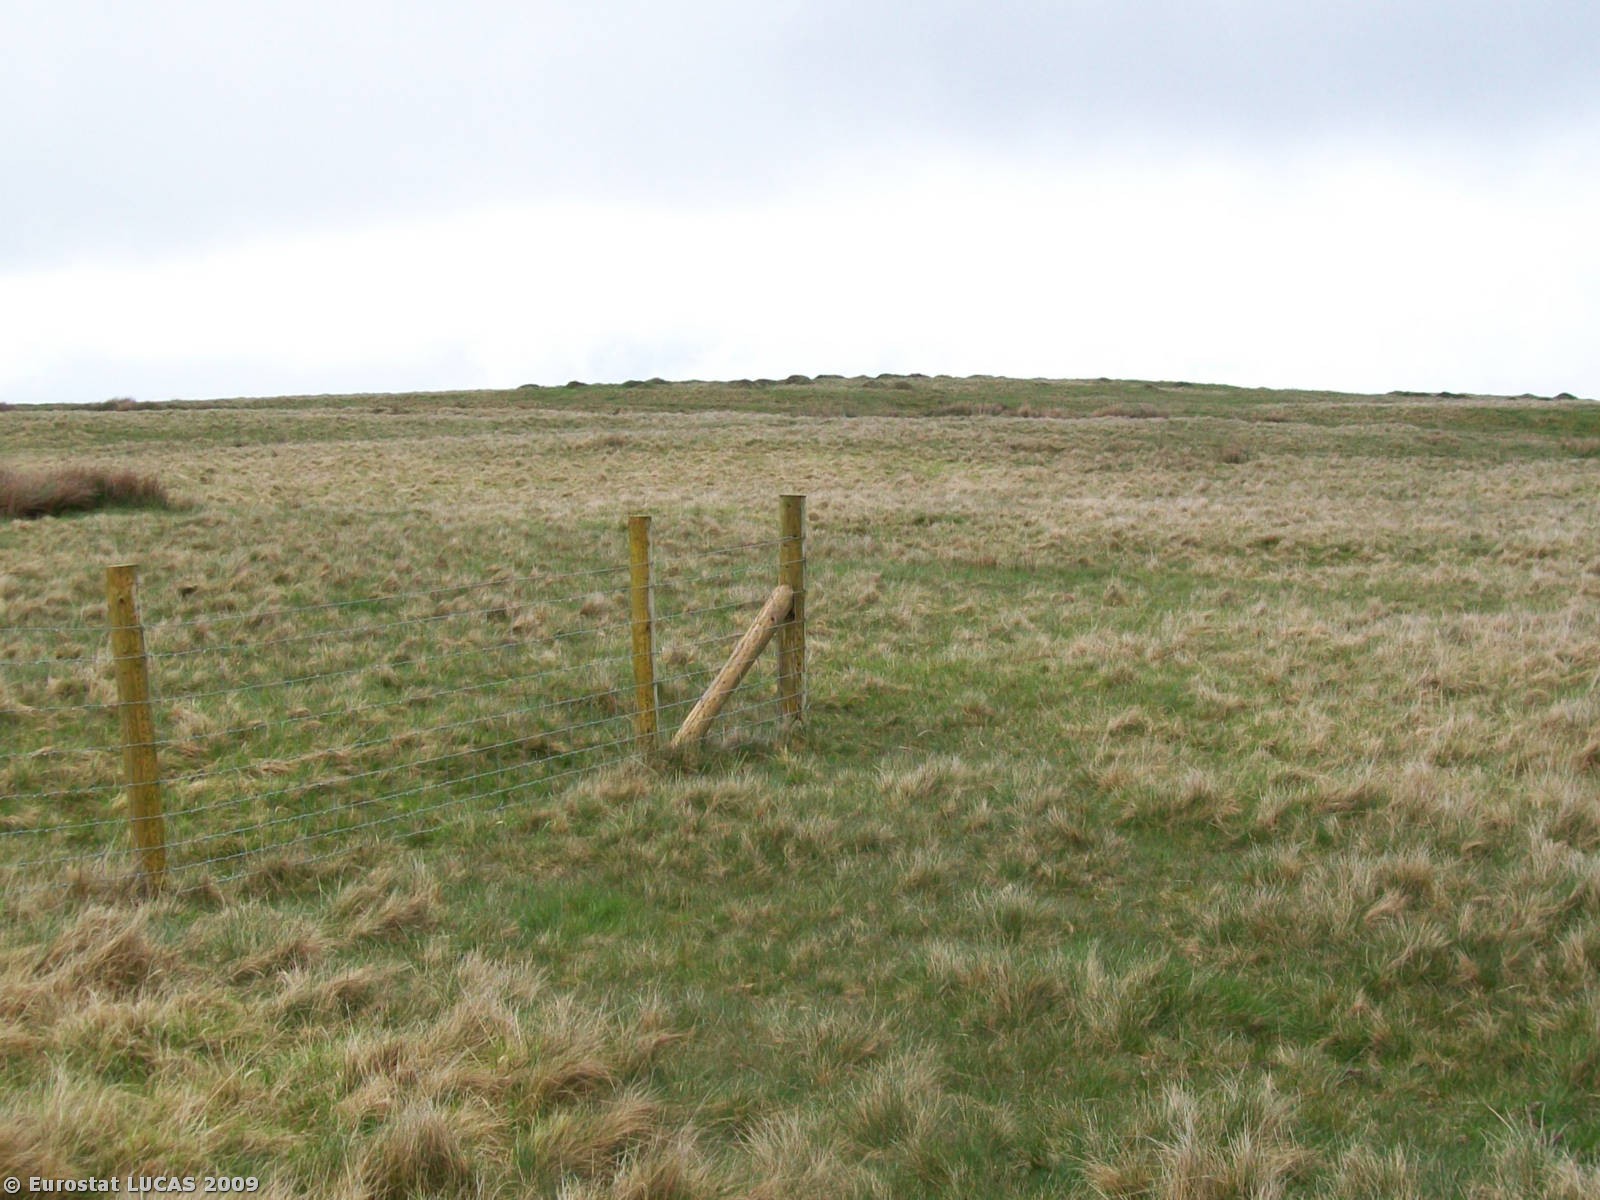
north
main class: Grassland
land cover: Grassland without tree/shrub cover
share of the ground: > 75 %
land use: Agriculture (excluding fallow land and kitchen gardens)
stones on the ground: < 10 %
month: May
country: GB
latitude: 51.9618
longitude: -3.6958
